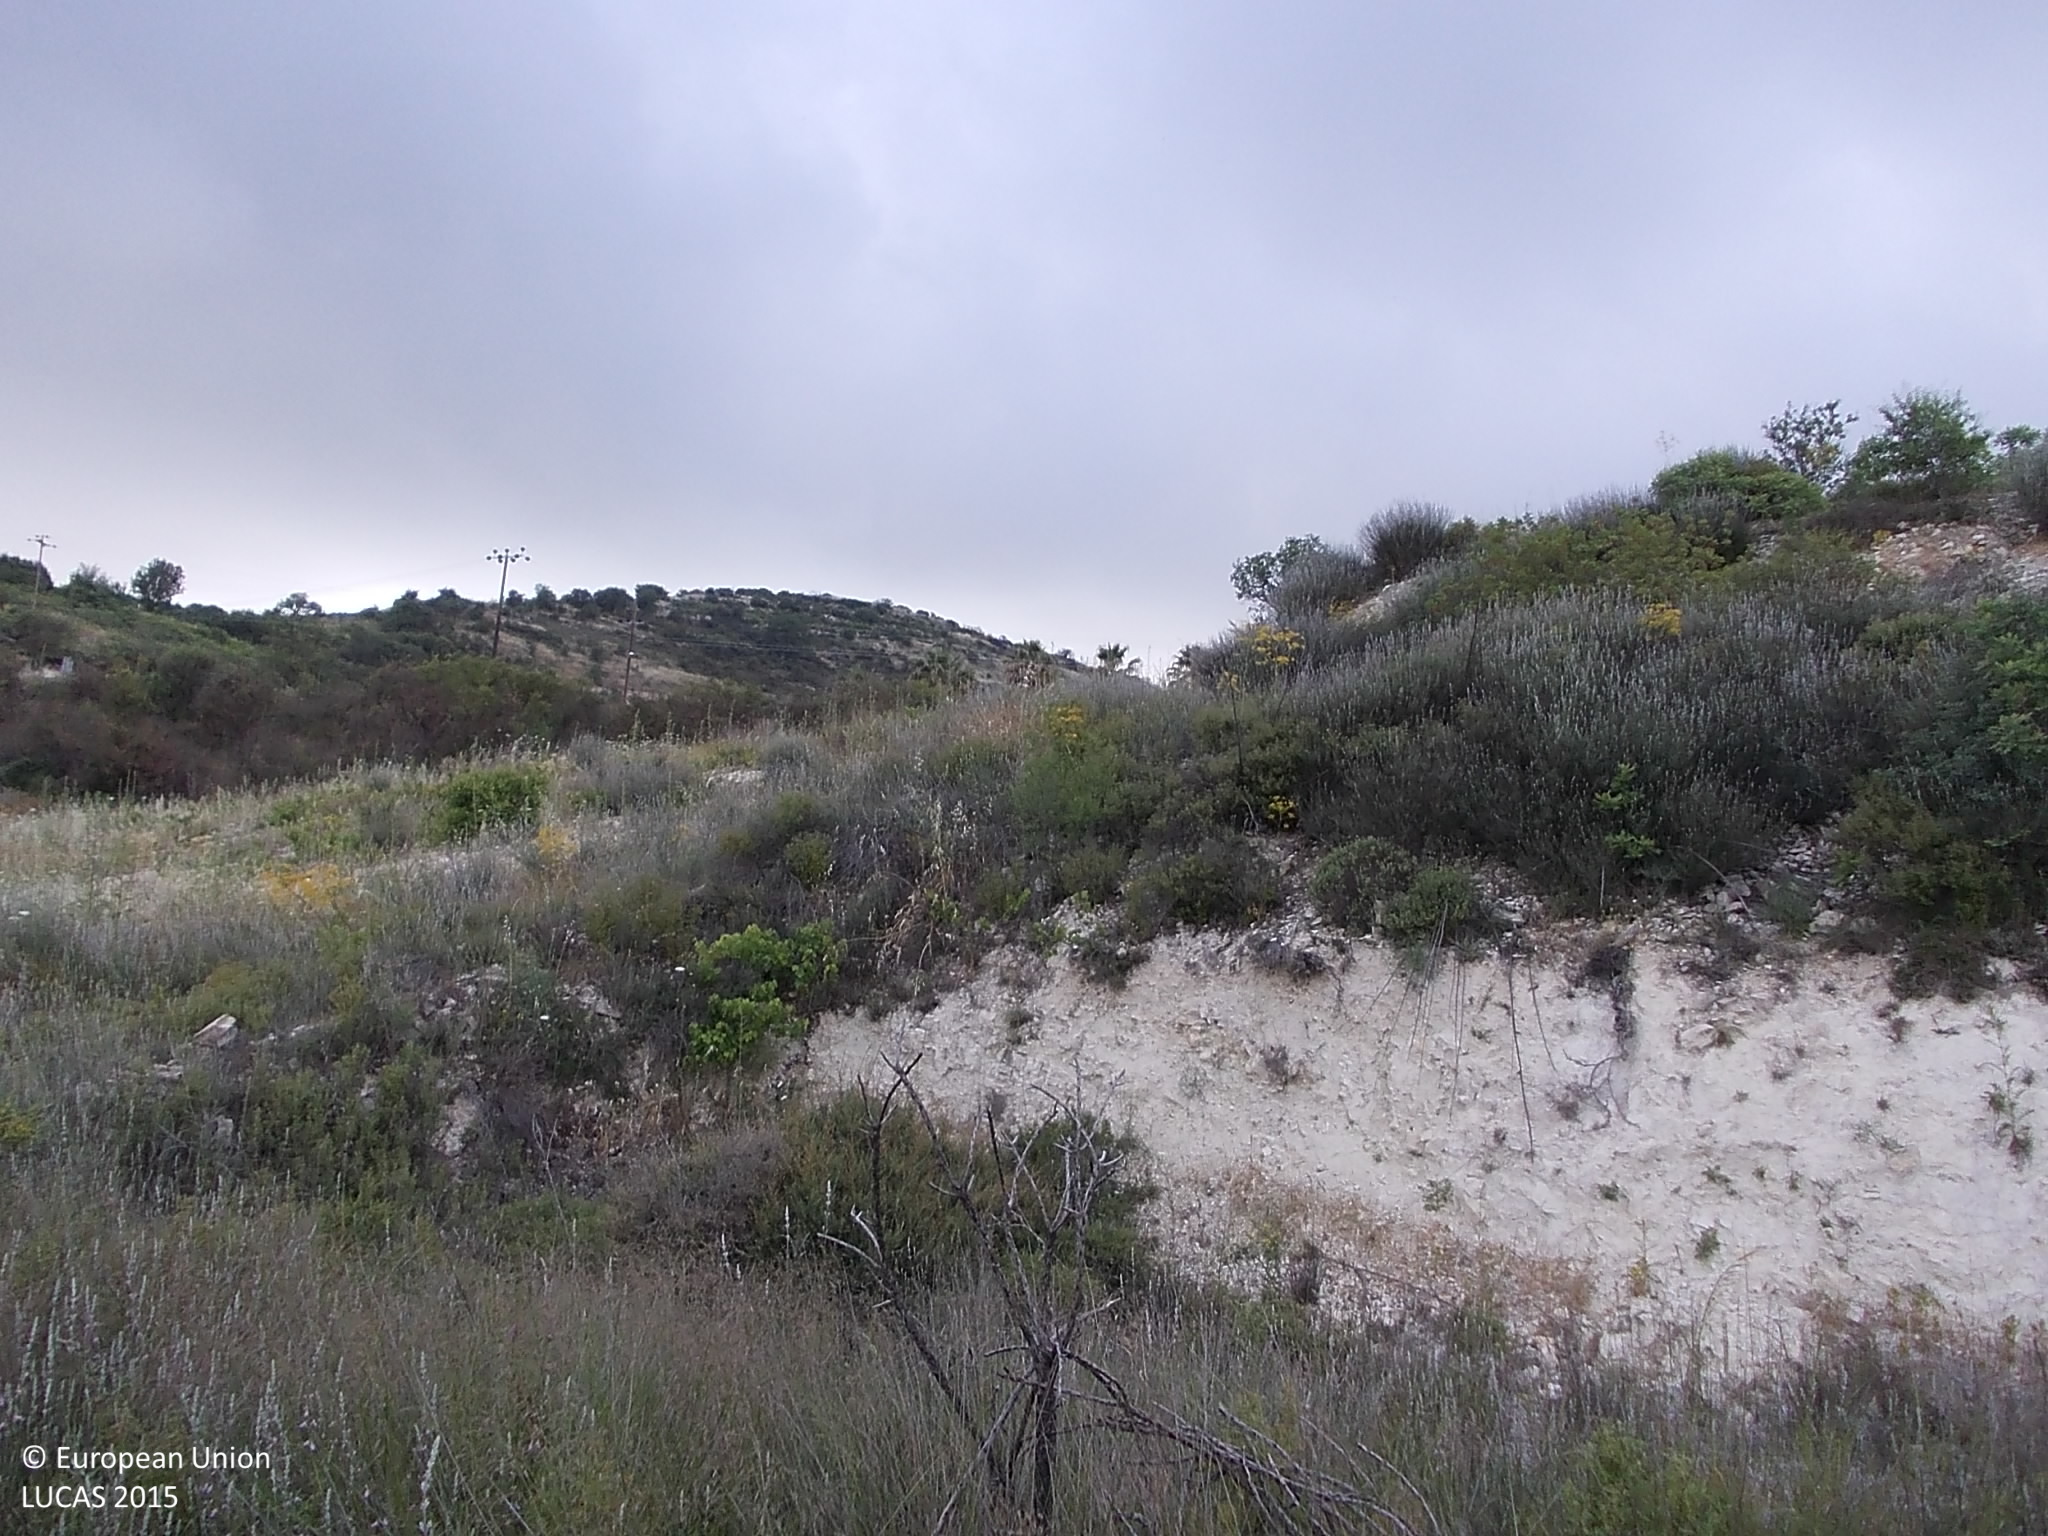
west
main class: Shrubland
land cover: Shrubland without tree cover
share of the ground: 10 - 25 %
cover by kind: herbaceous plants 75 %, shrubs 25 %
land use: Semi-natural and natural areas not in use
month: May
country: CY
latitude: 34.8425
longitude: 32.8094
